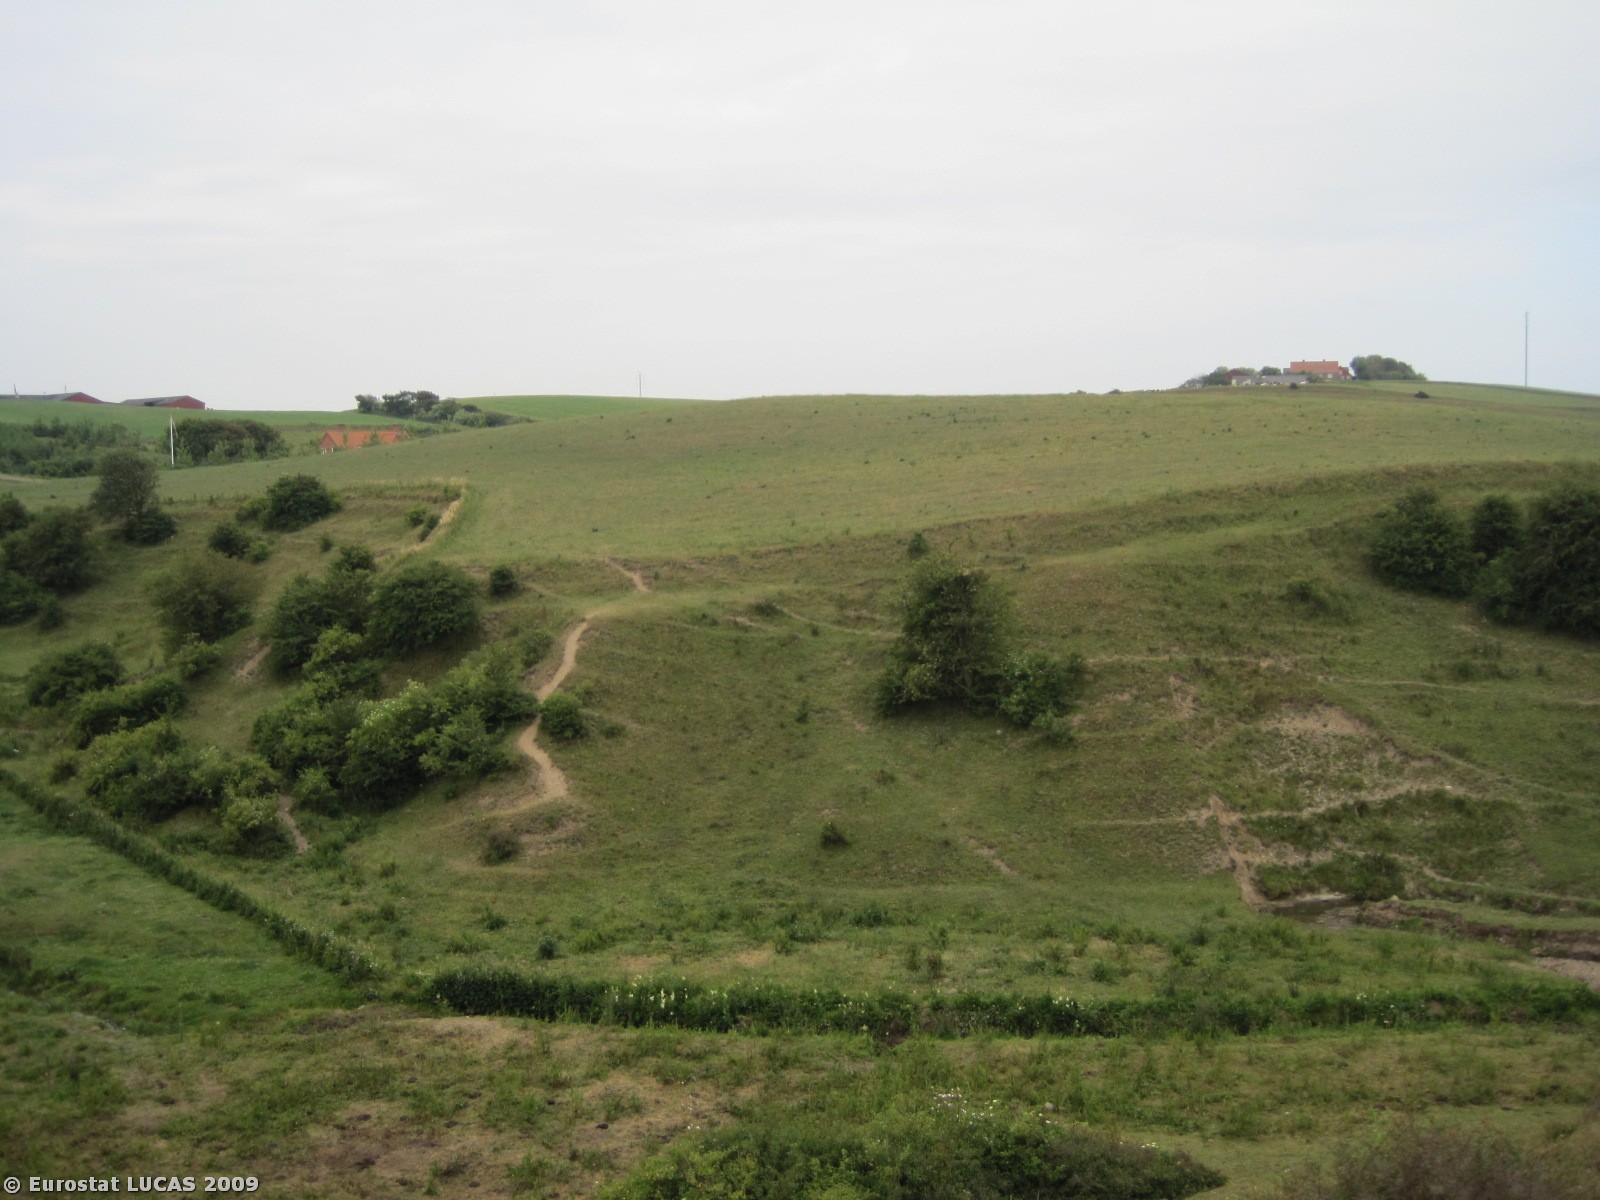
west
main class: Grassland
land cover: Grassland with sparse tree/shrub cover
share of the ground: > 75 %
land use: Agriculture (excluding fallow land and kitchen gardens)
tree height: < 5 m
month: June
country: DK
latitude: 56.5365
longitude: 8.3272
